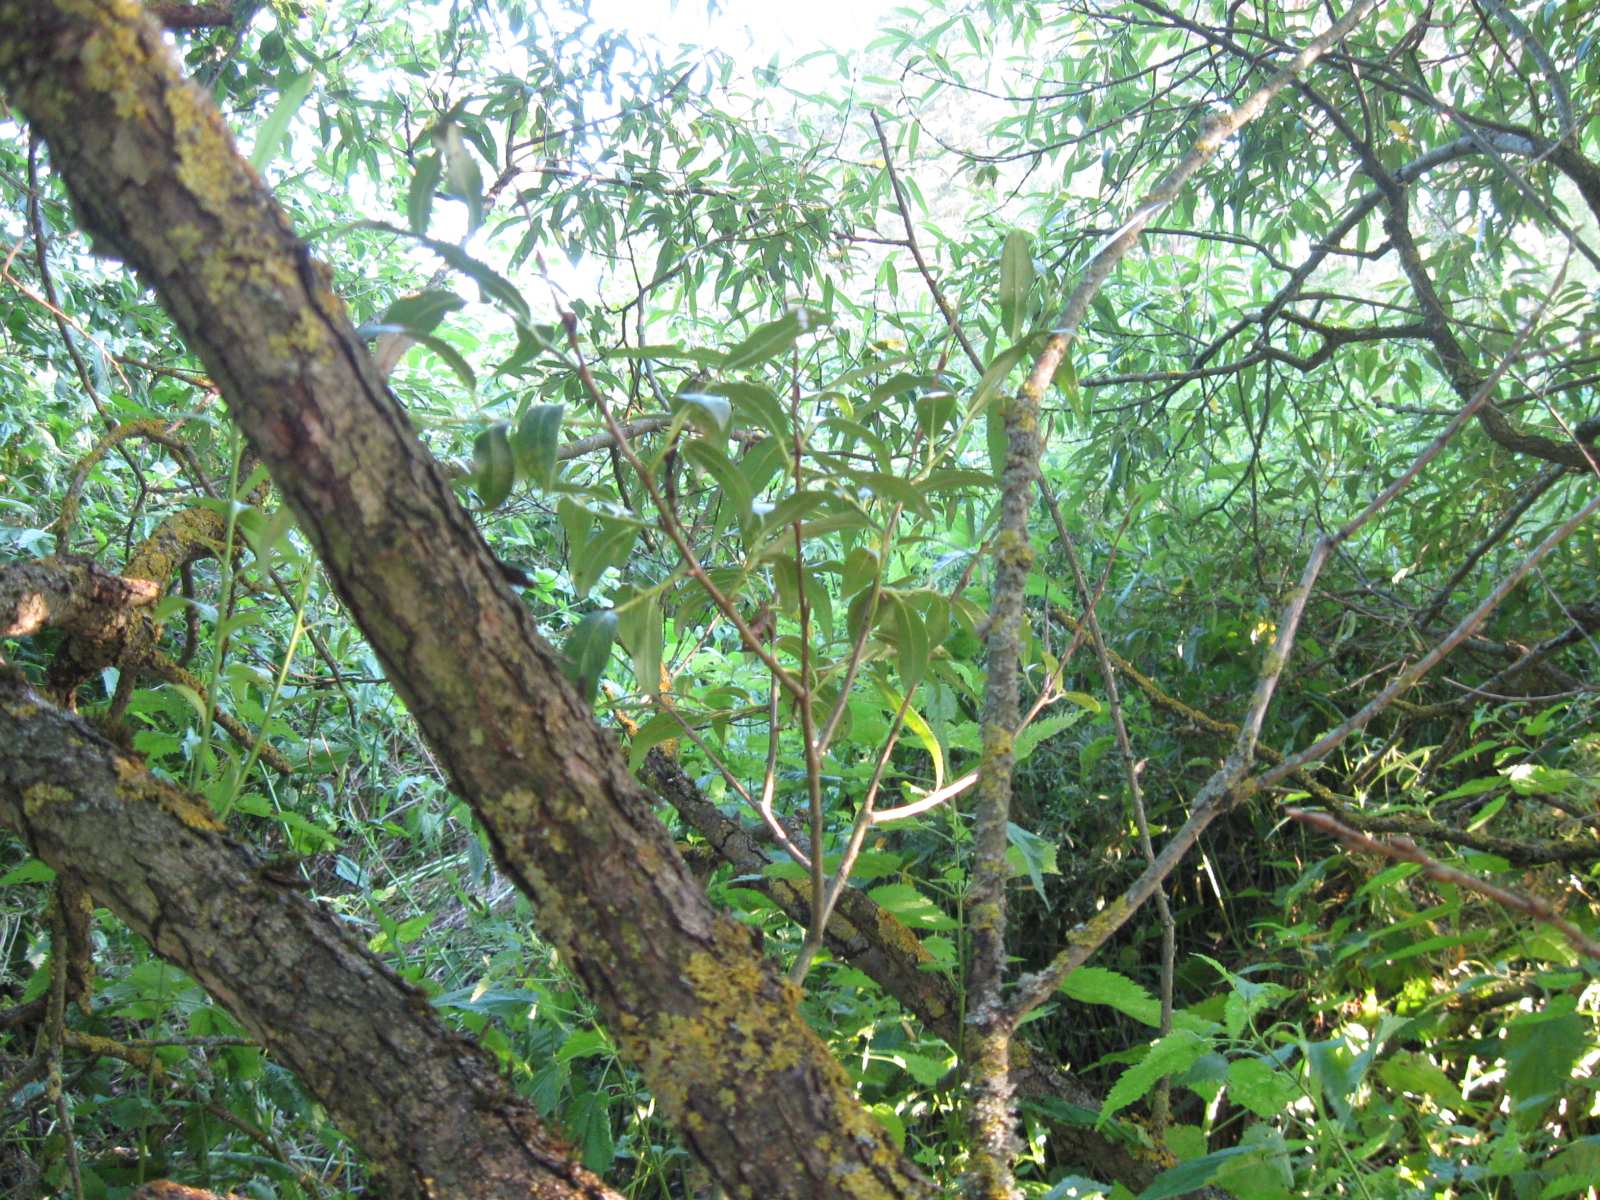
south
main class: Woodland
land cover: Broadleaved woodland
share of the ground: > 75 %
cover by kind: broadleaved forest trees 80 %, herbaceous plants 20 %
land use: Semi-natural and natural areas not in use
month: July
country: LT
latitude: 54.3338
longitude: 23.5397
